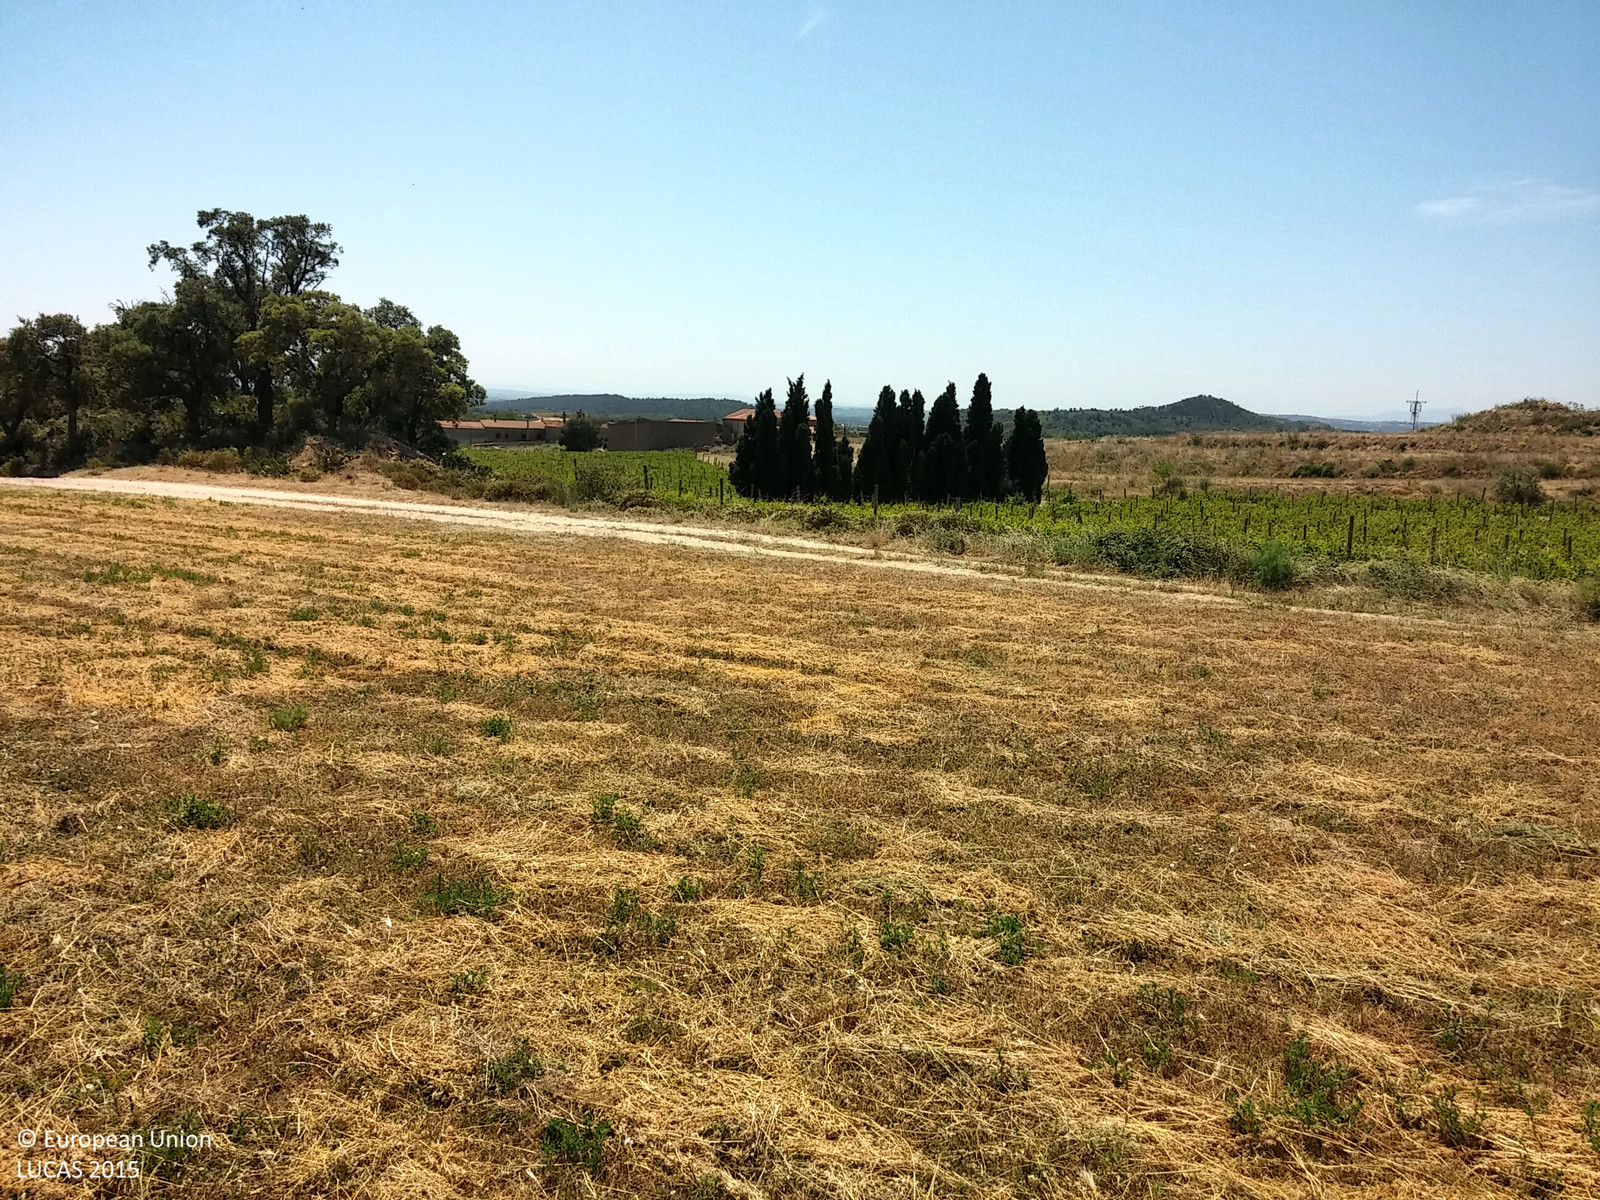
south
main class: Cropland
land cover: Lucerne
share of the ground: > 75 %
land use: Agriculture (excluding fallow land and kitchen gardens)
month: May
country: ES
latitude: 42.3742
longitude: 2.9822
